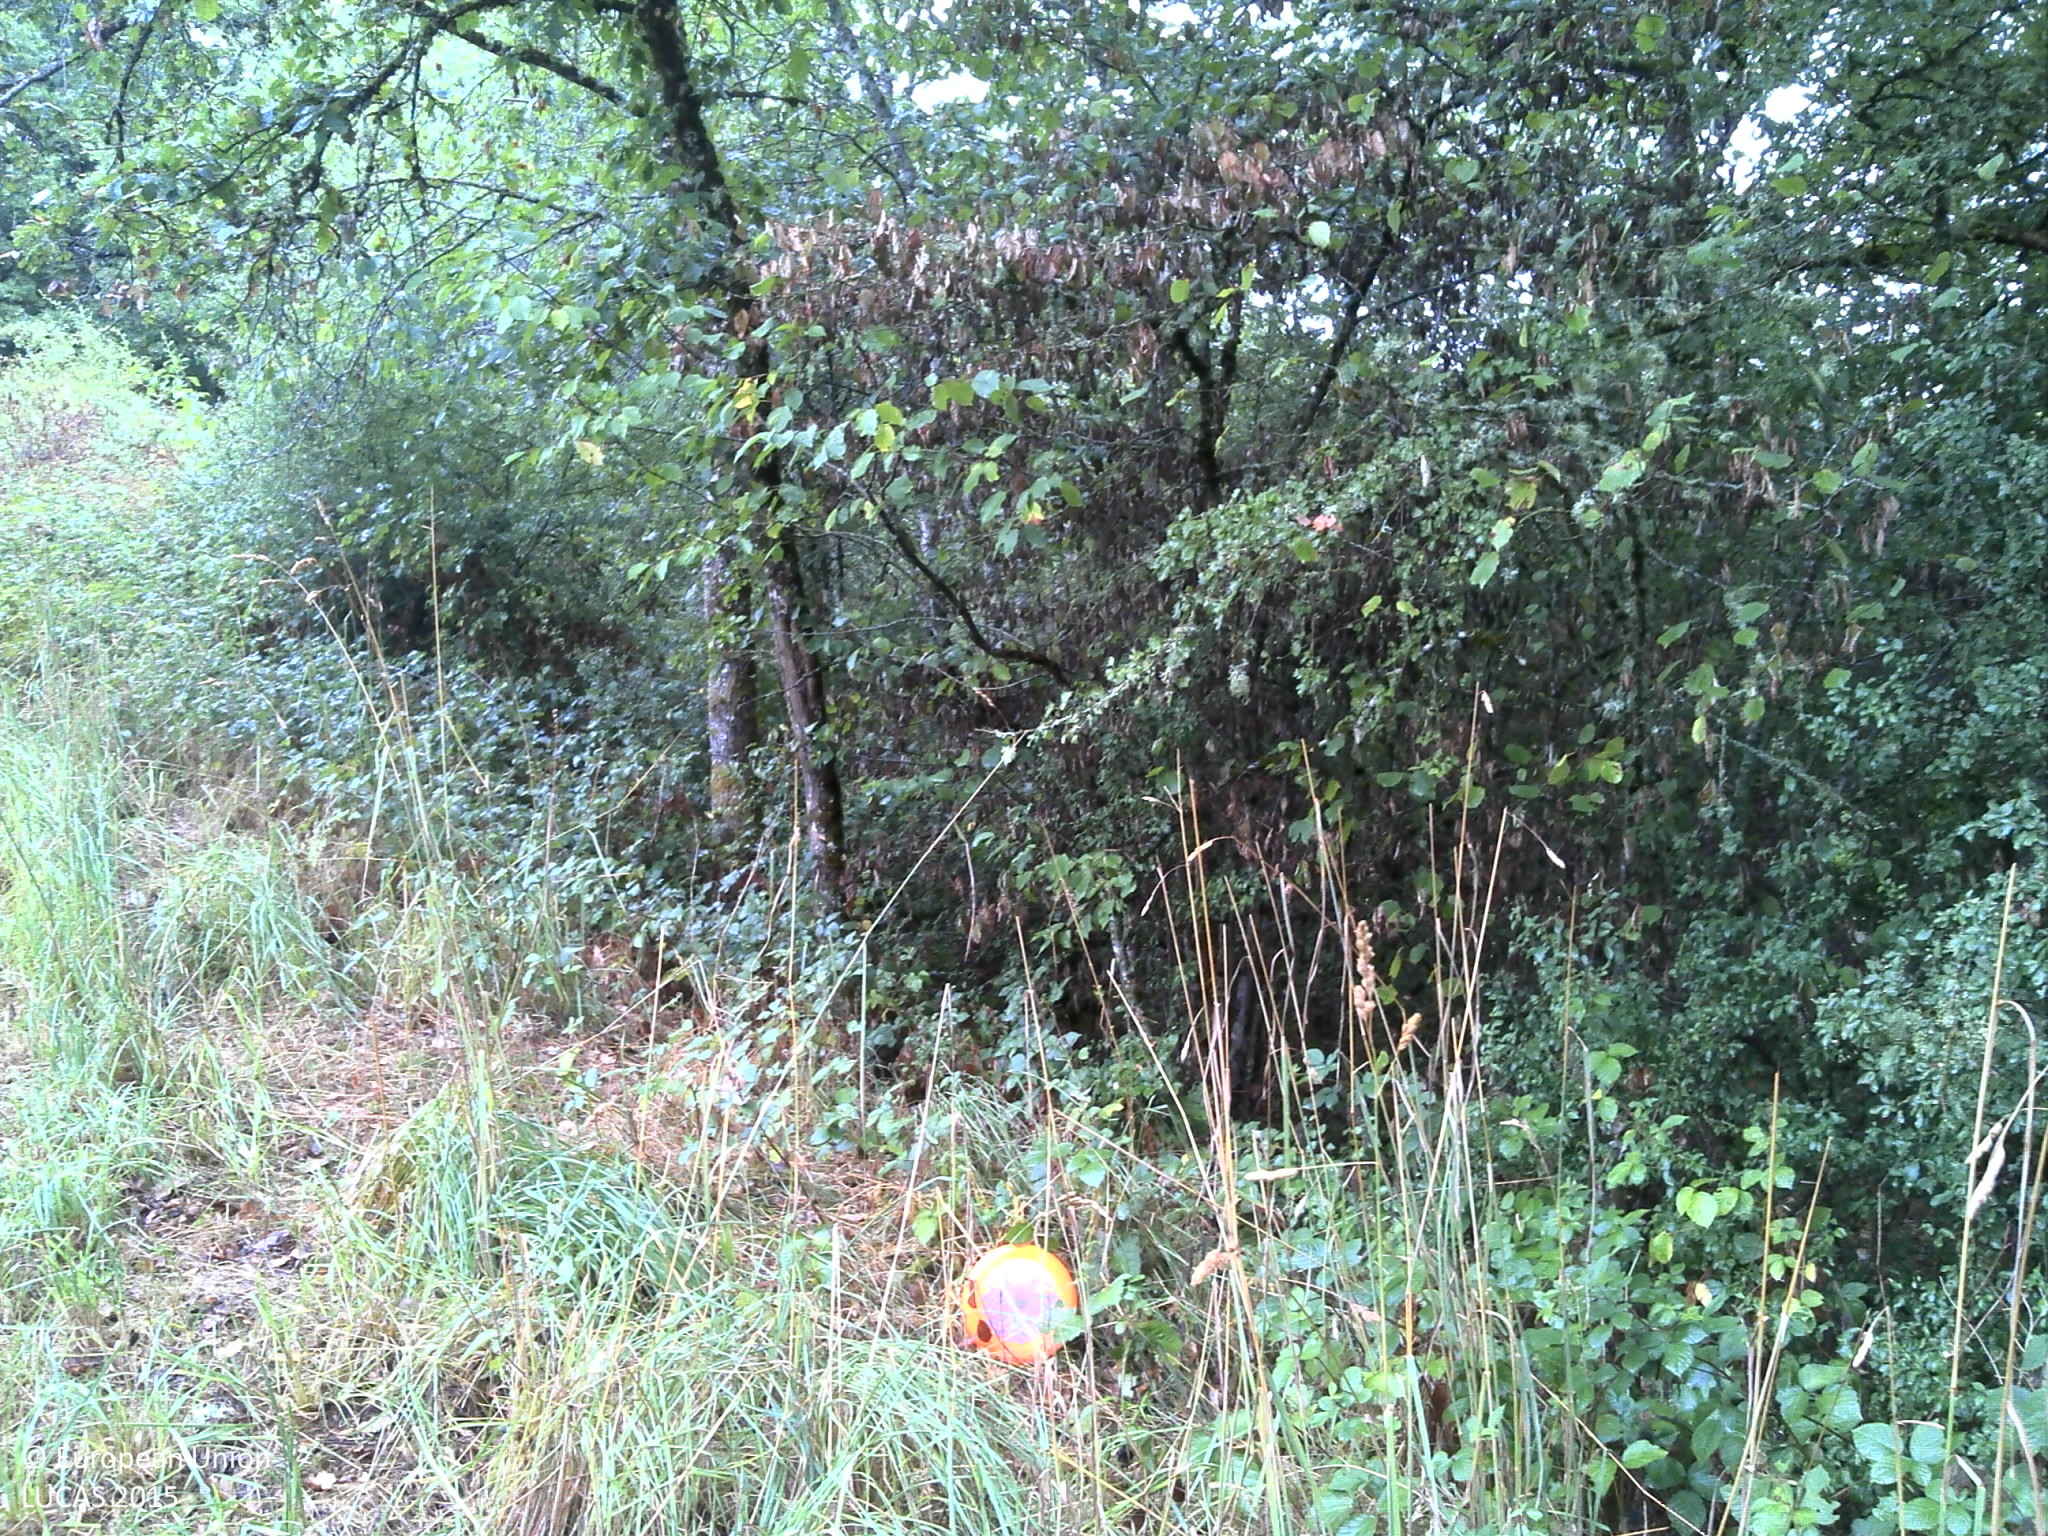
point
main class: Grassland
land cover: Grassland without tree/shrub cover
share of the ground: > 75 %
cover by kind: herbaceous plants 90 %, unconsolidated bare surface 10 %
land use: Agriculture (excluding fallow land and kitchen gardens)
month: August
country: FR
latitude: 45.4306
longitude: 2.4187
